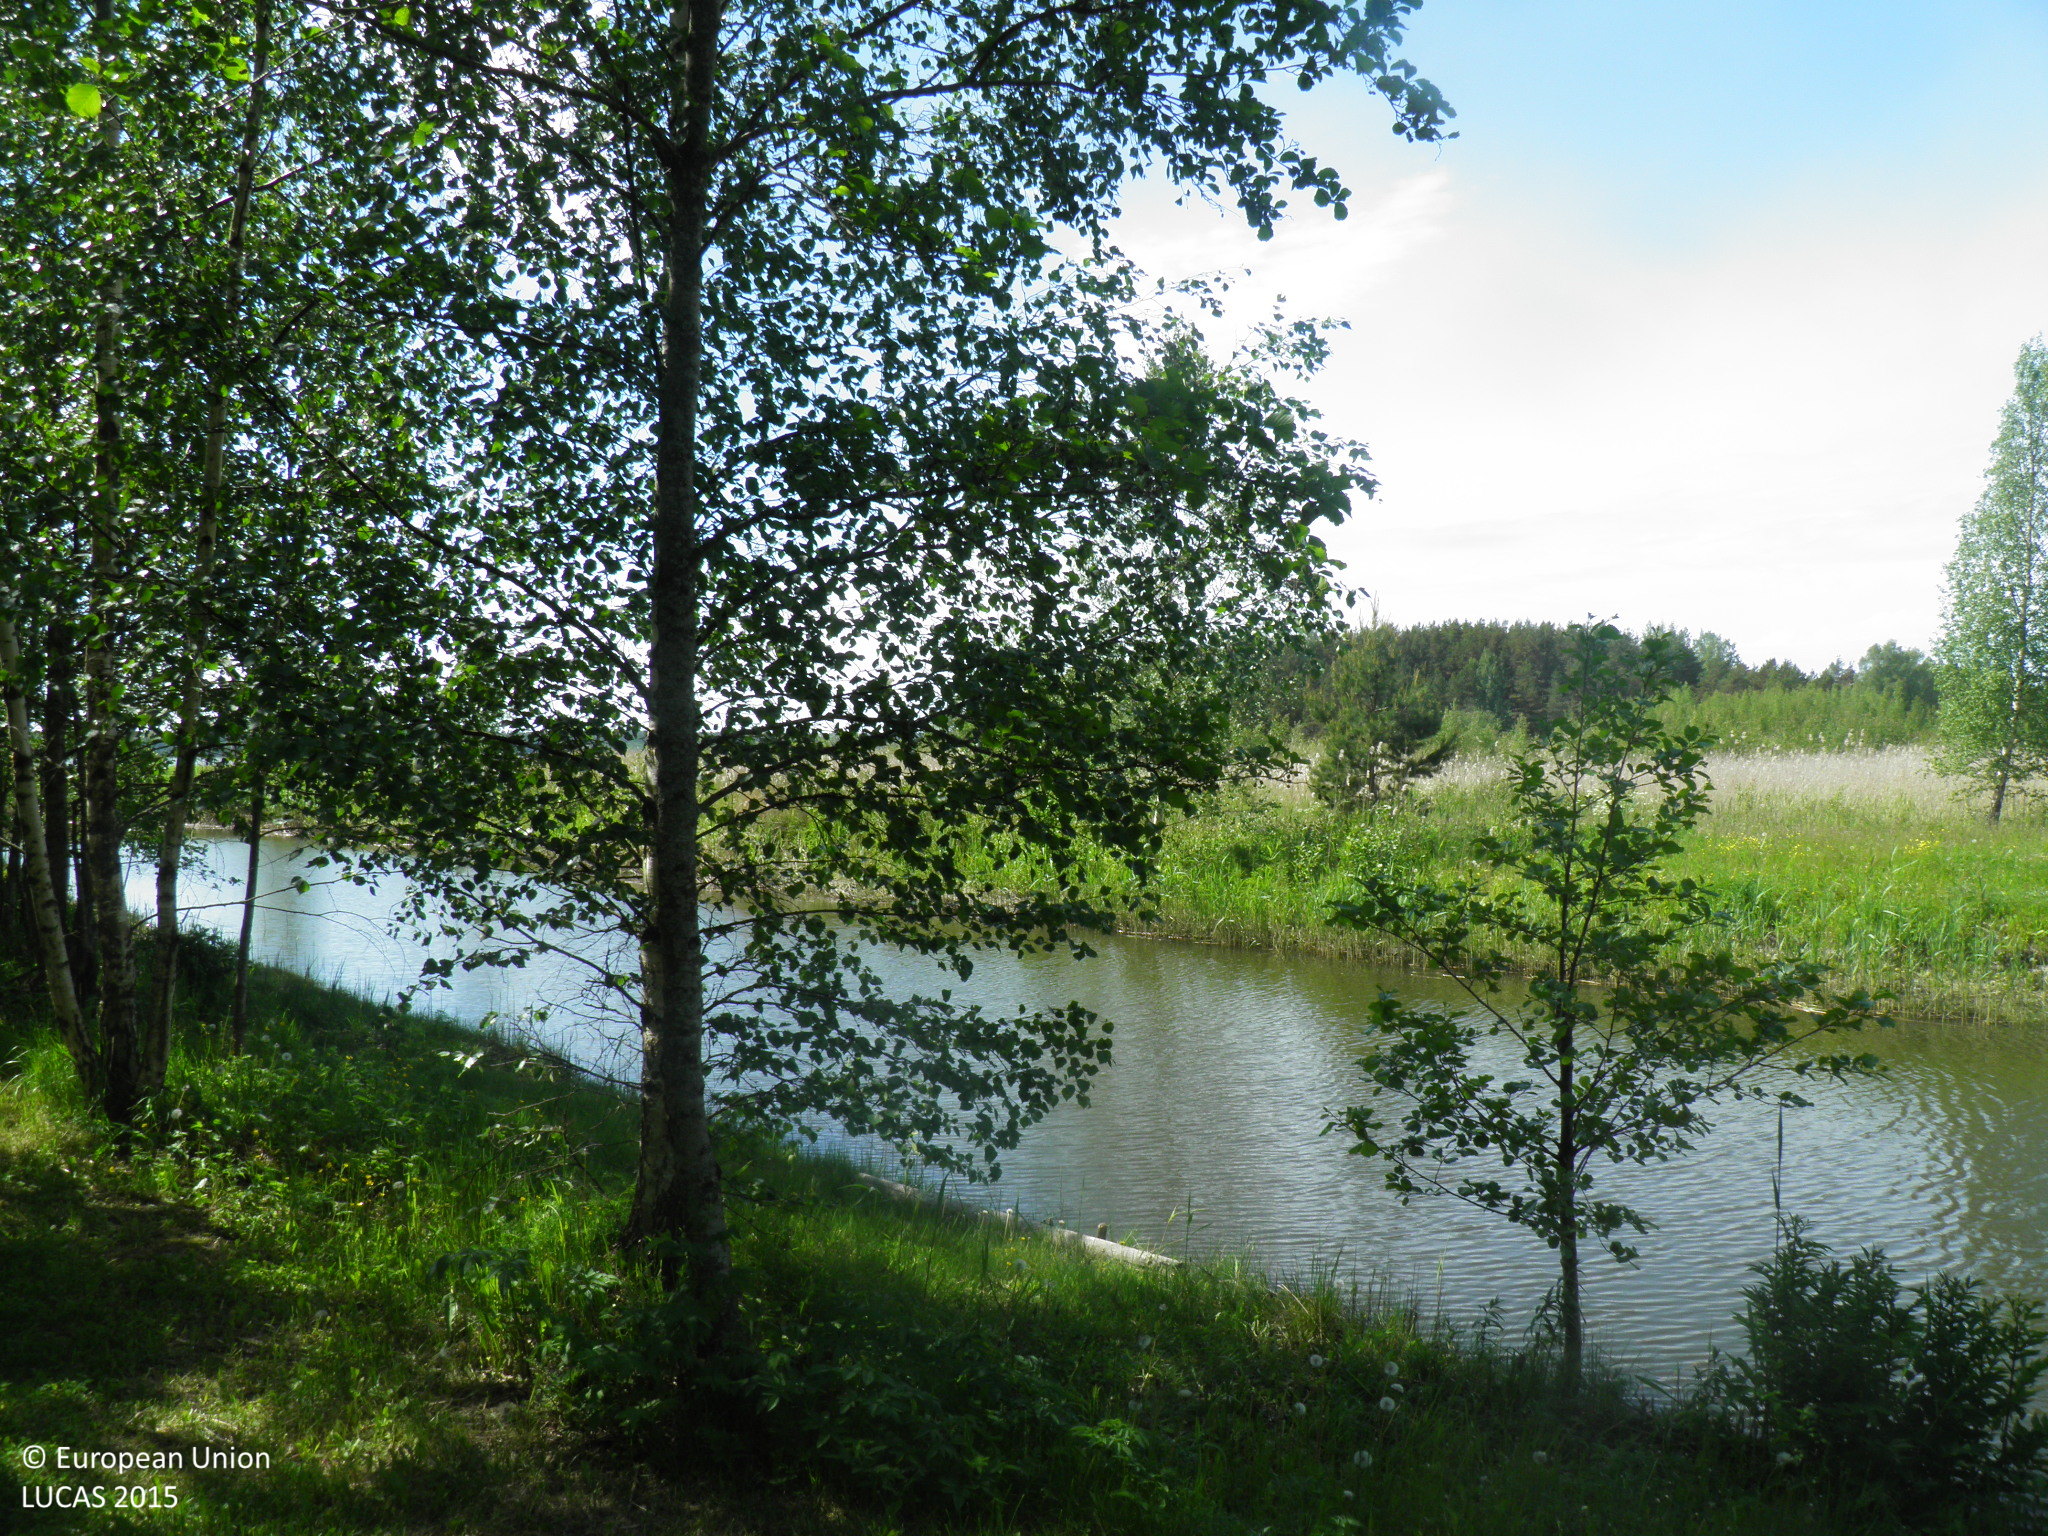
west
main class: Woodland
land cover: Broadleaved woodland
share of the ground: 50 - 75 %
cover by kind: broadleaved forest trees 55 %, herbaceous plants 45 %
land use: Amenities, museums, leisure
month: June
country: FI
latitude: 60.5567
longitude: 21.8235
